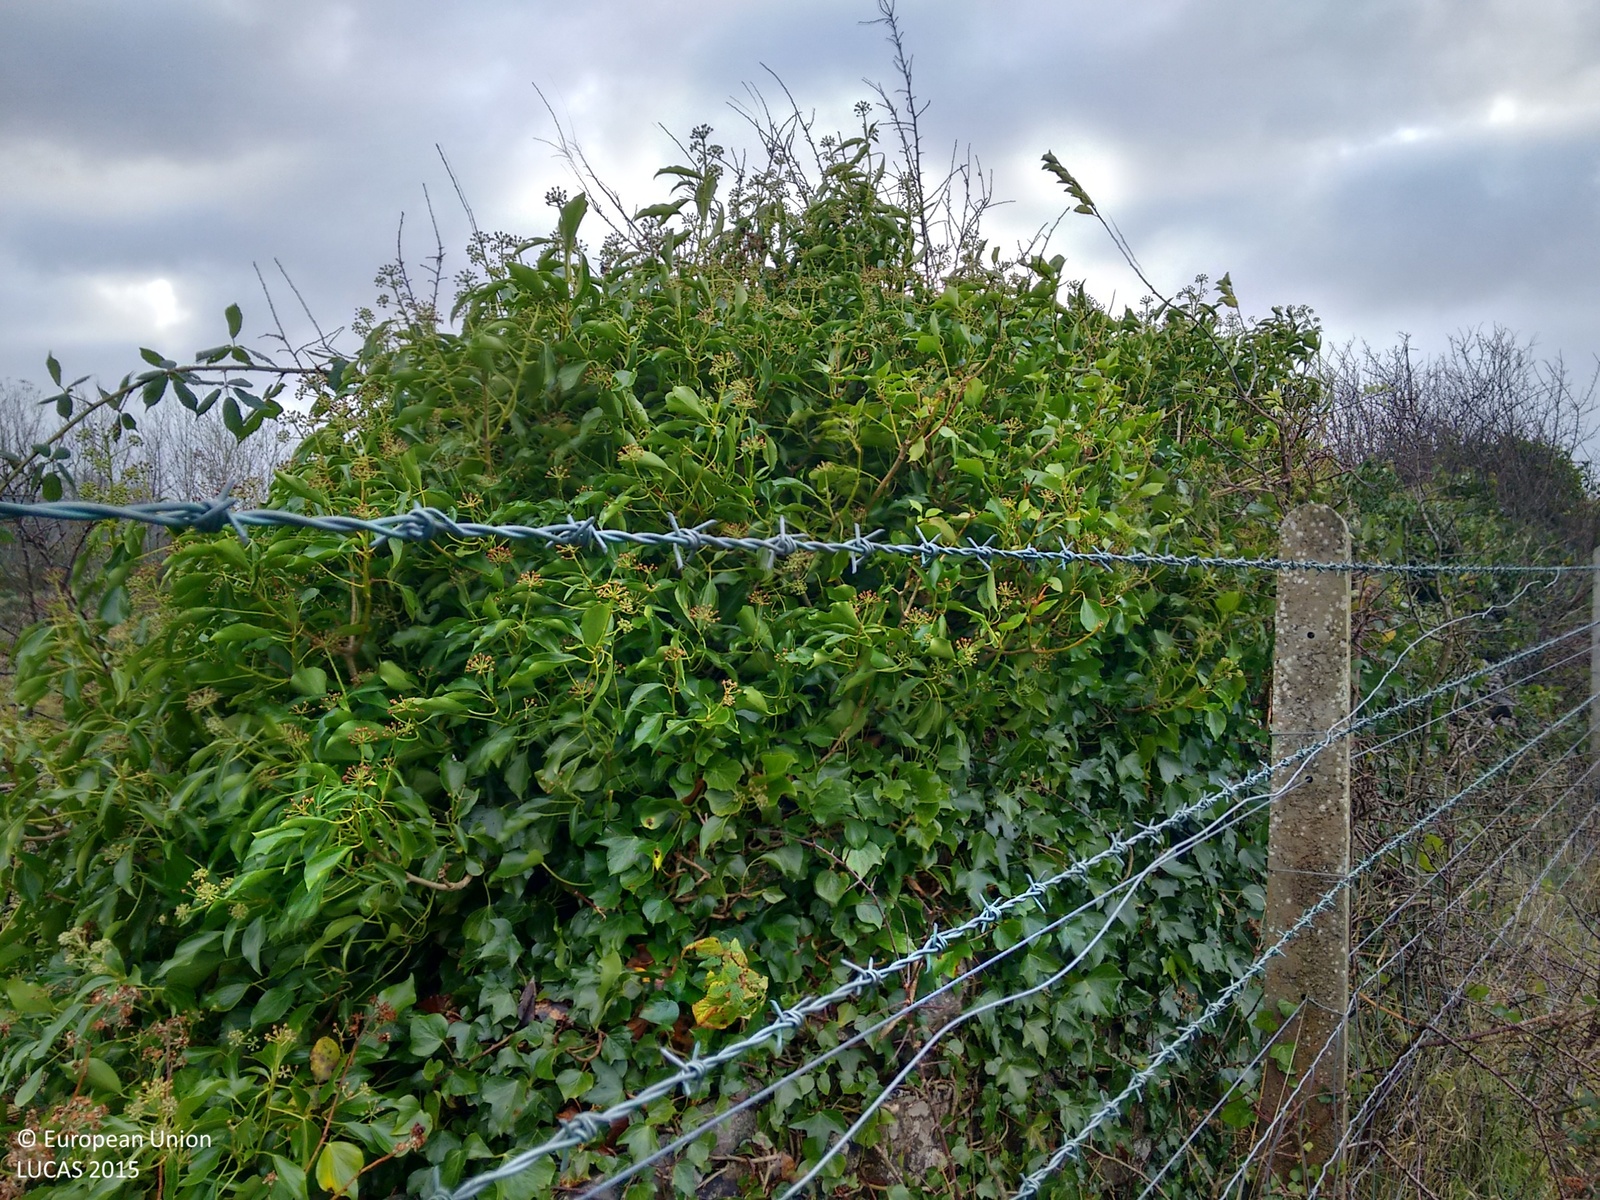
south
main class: Grassland
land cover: Grassland without tree/shrub cover
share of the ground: > 75 %
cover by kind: herbaceous plants 100 %
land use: Railway transport
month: November
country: IE
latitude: 54.2325
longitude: -8.4938
